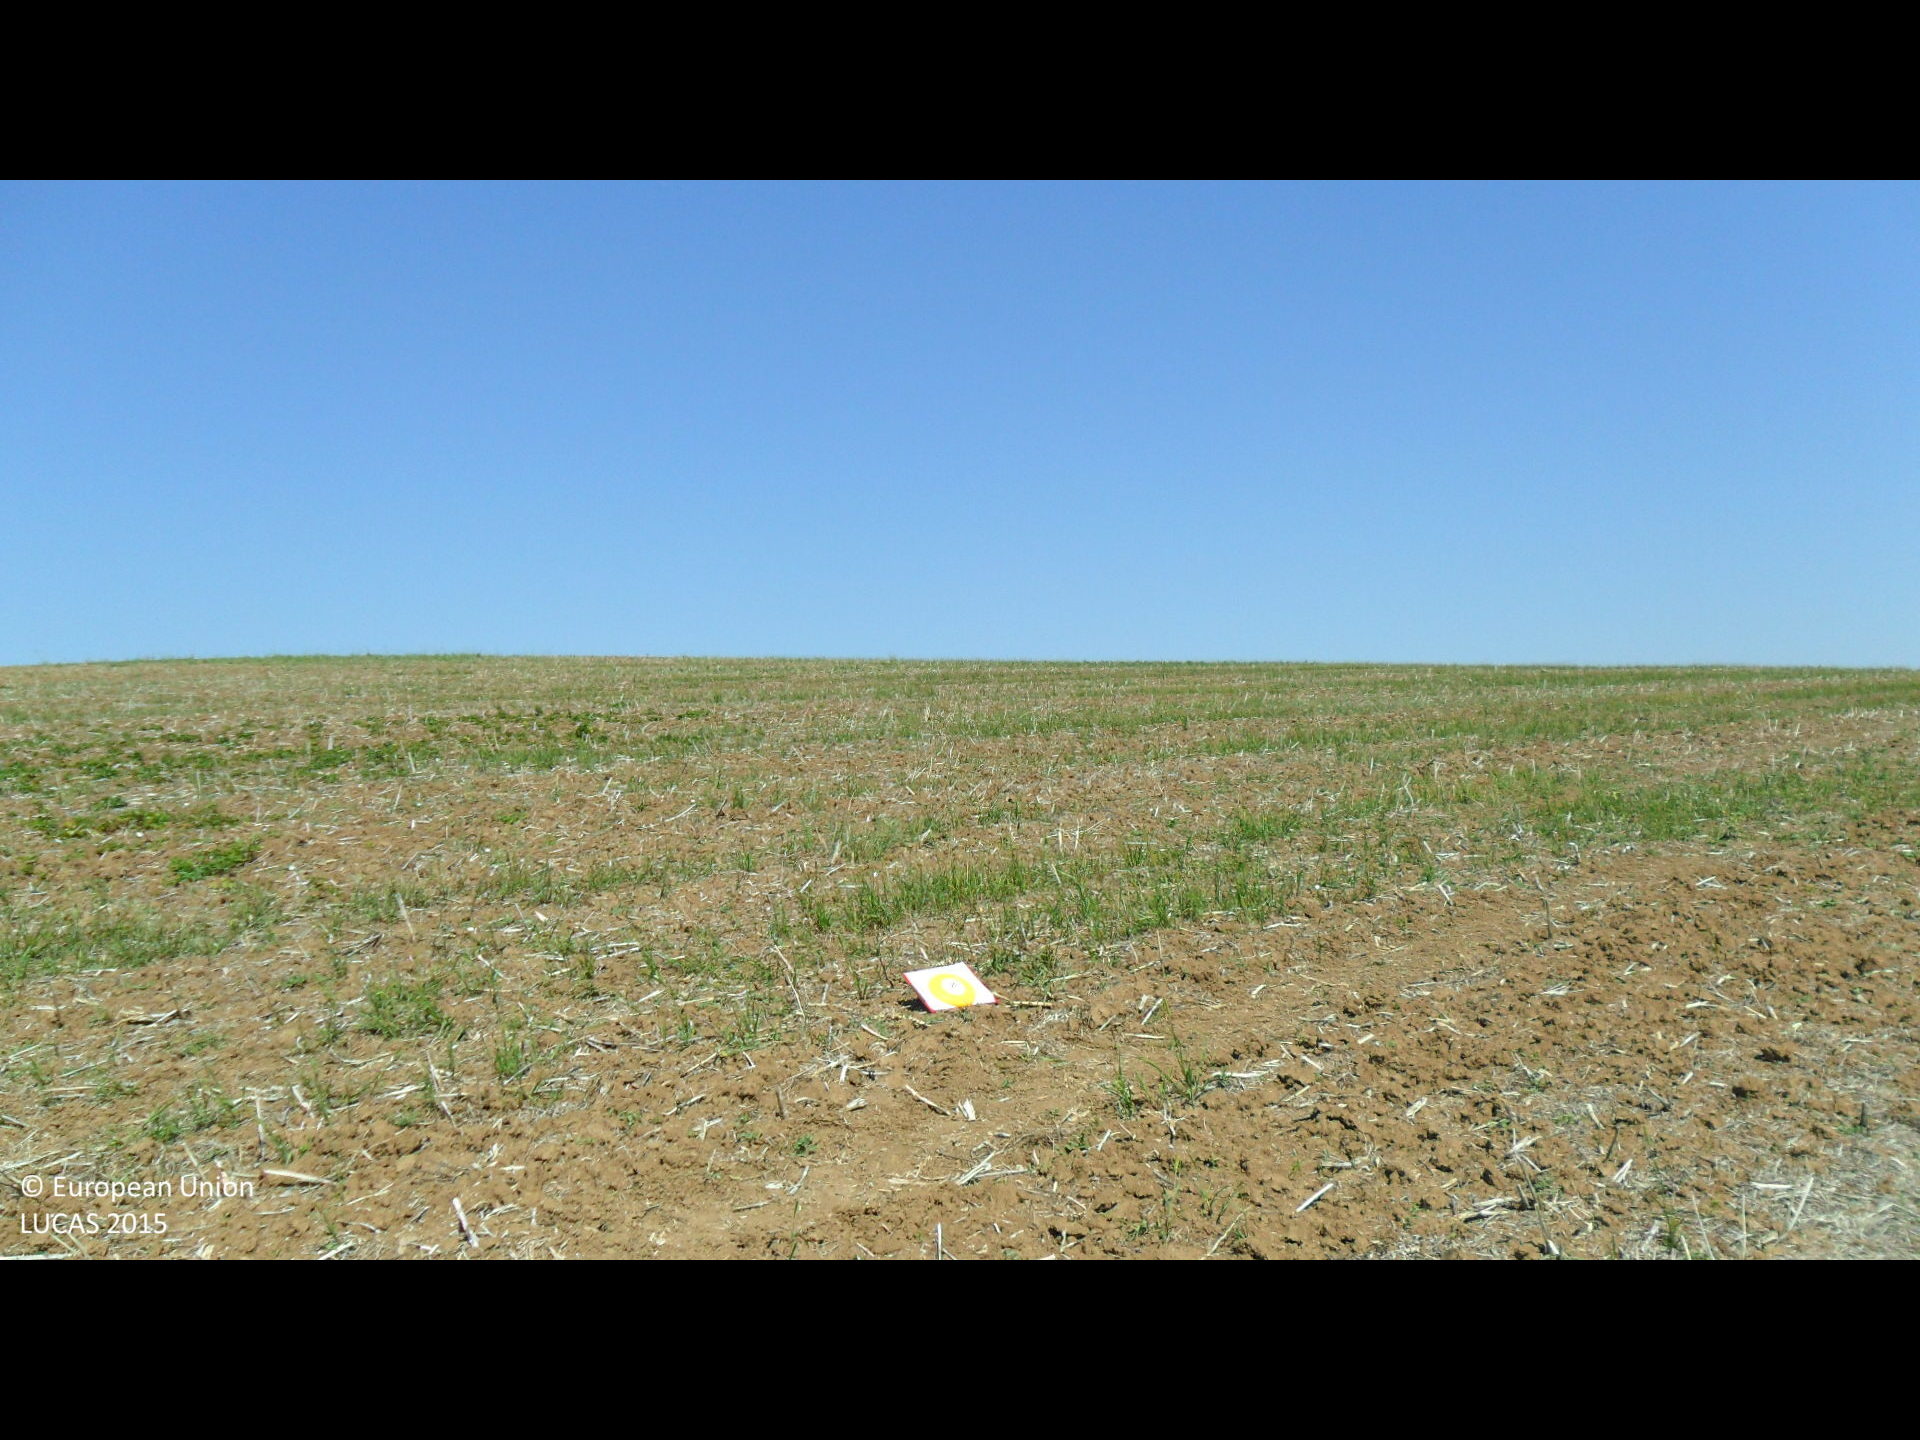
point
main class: Cropland
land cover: Rape and turnip rape
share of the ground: < 10 %
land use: Agriculture (excluding fallow land and kitchen gardens)
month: August
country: BG
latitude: 43.5021
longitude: 26.2384
